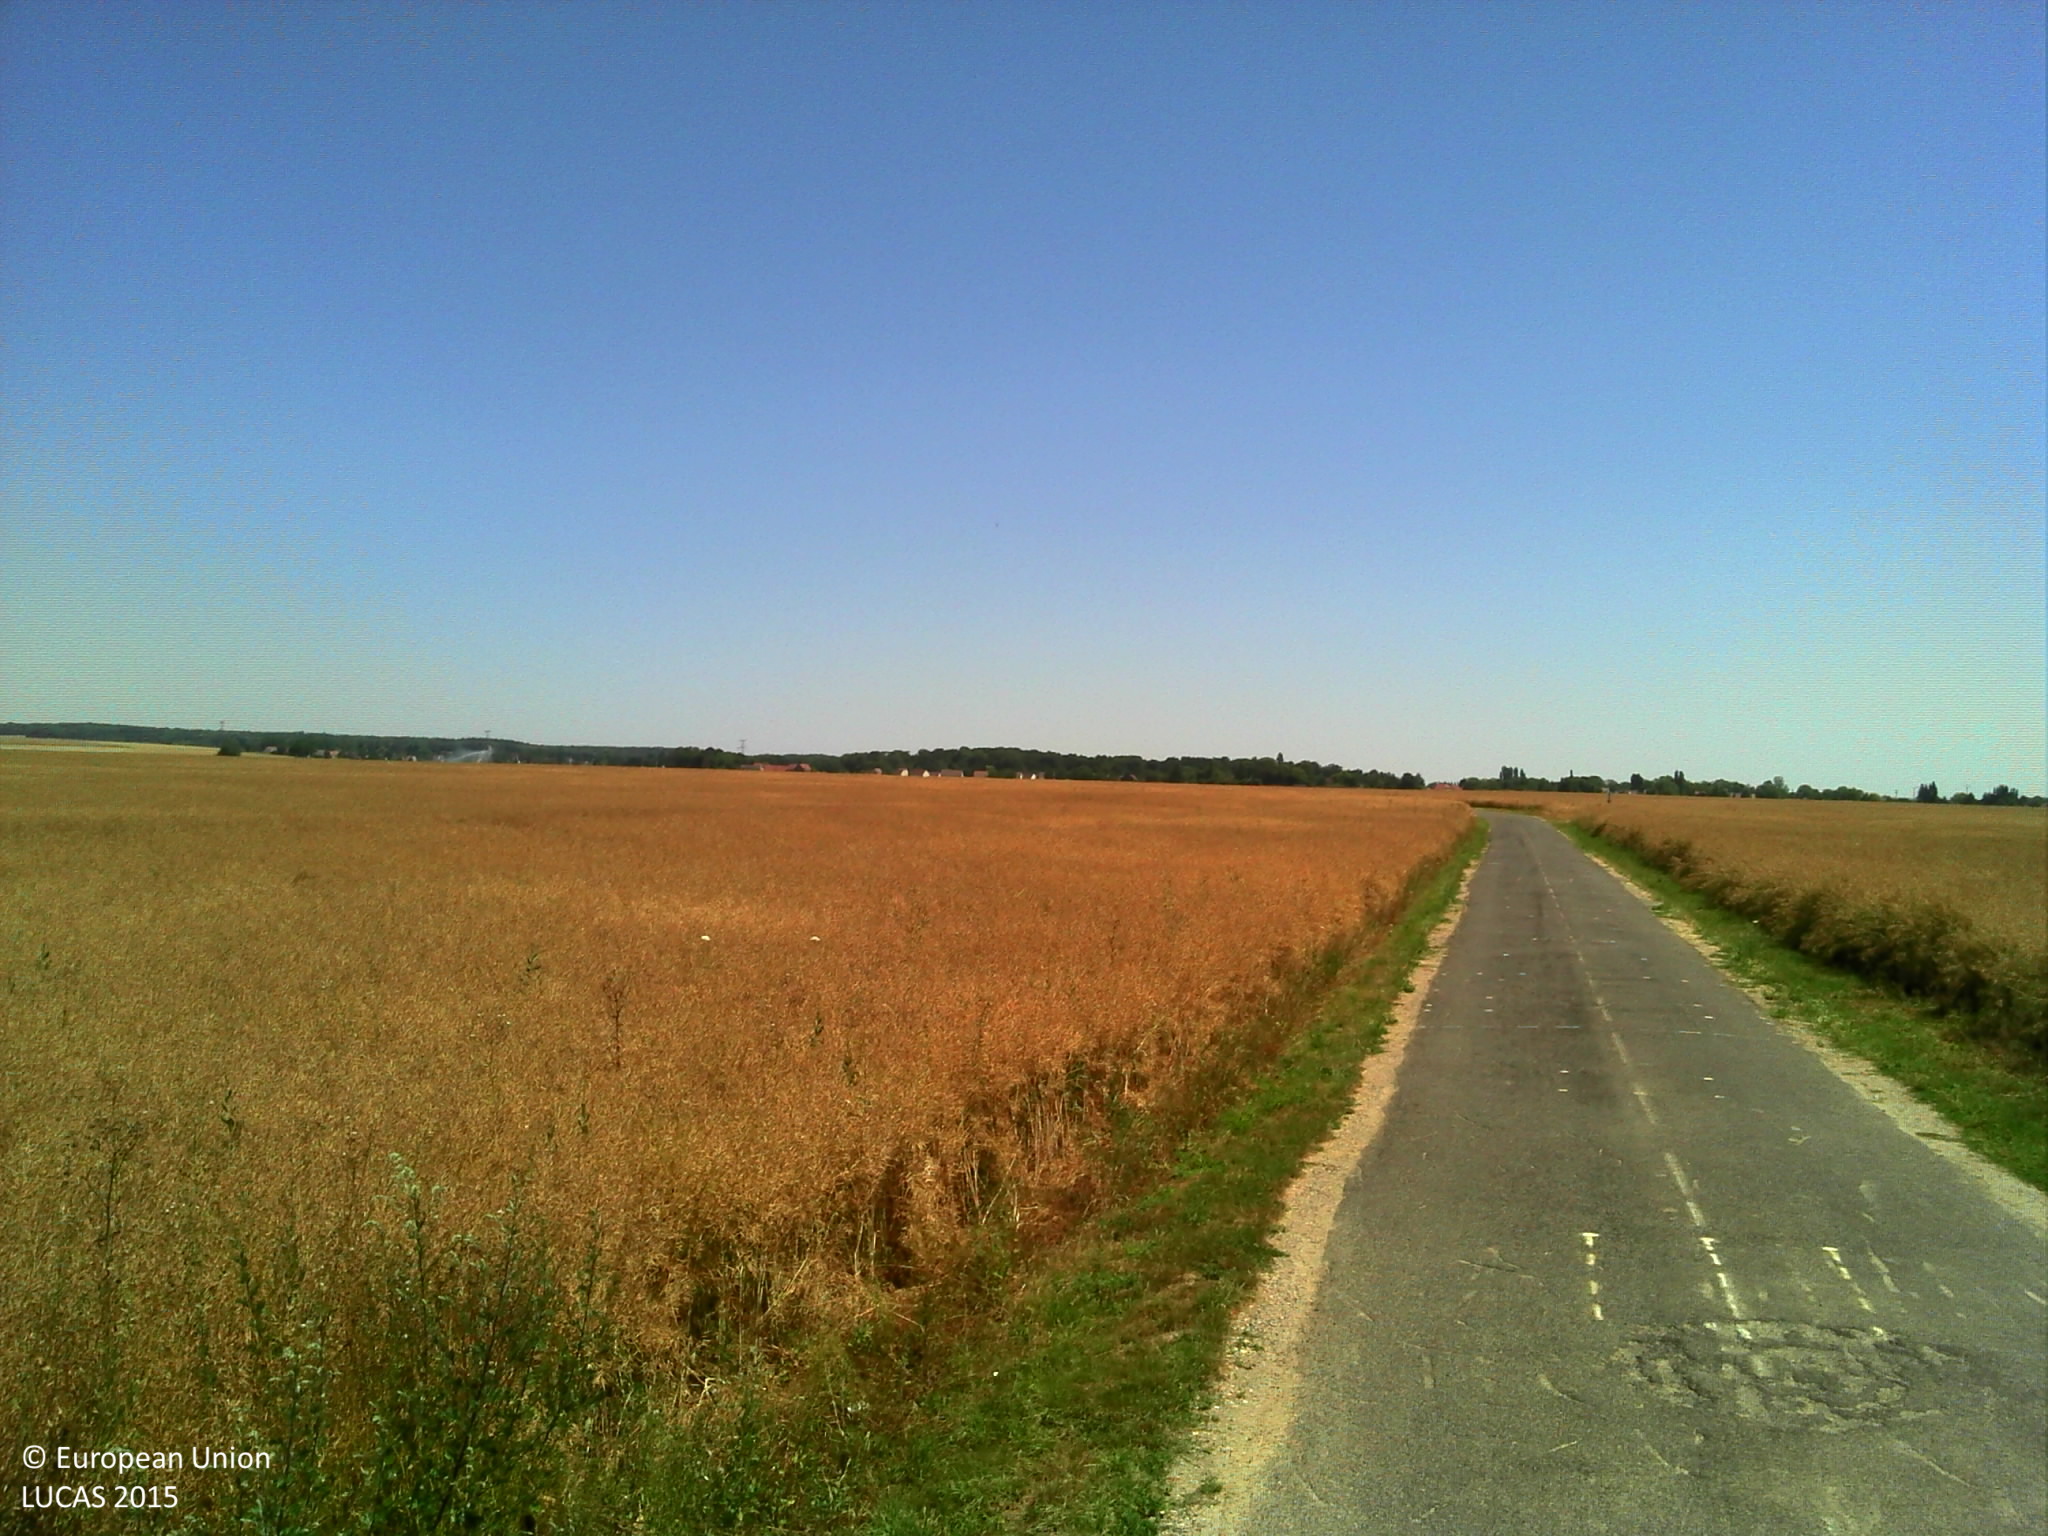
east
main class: Cropland
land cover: Rape and turnip rape
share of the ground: > 75 %
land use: Agriculture (excluding fallow land and kitchen gardens)
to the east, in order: Rape and turnip rape
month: July
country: FR
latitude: 49.2485
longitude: 1.9485
